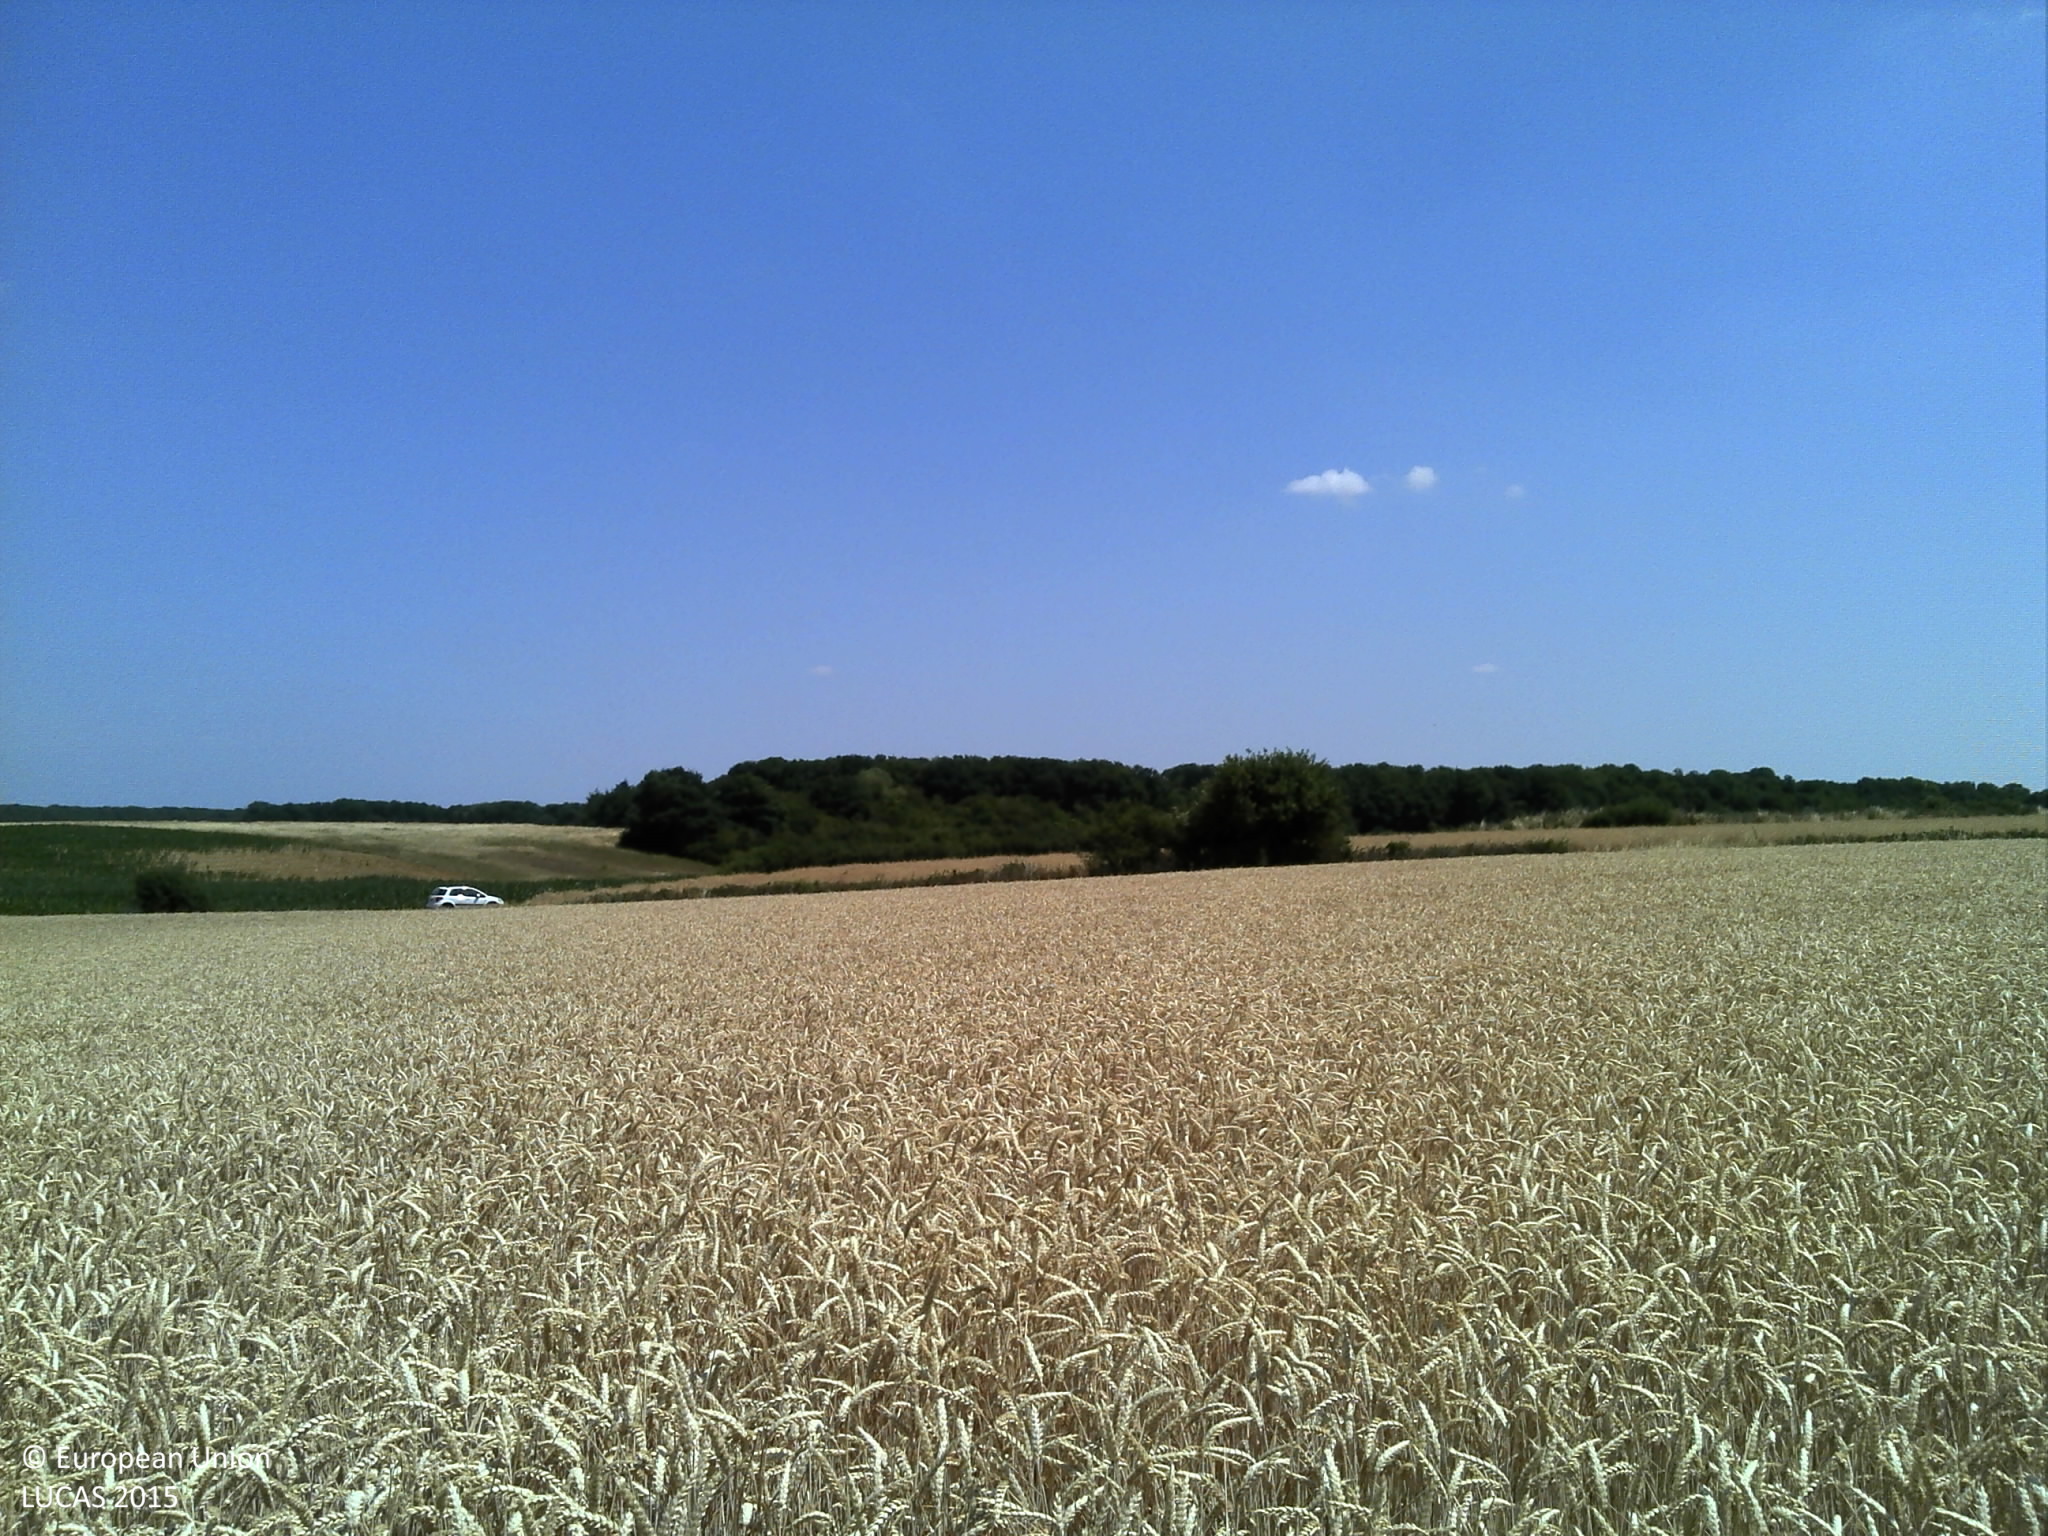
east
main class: Cropland
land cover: Common wheat
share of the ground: > 75 %
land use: Agriculture (excluding fallow land and kitchen gardens)
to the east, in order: Common wheat; Grass margins; Managed hedges; Grass margins; Tracks; Grass margins; Rape and turnip rape; Tracks; Grass margins; Shrubland without tree cover; Grassland without tree/shrub cover; Abandoned hedges; Grass margins; Tracks; Grassland without tree/shrub cover
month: July
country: FR
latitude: 48.4903
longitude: 1.9623
